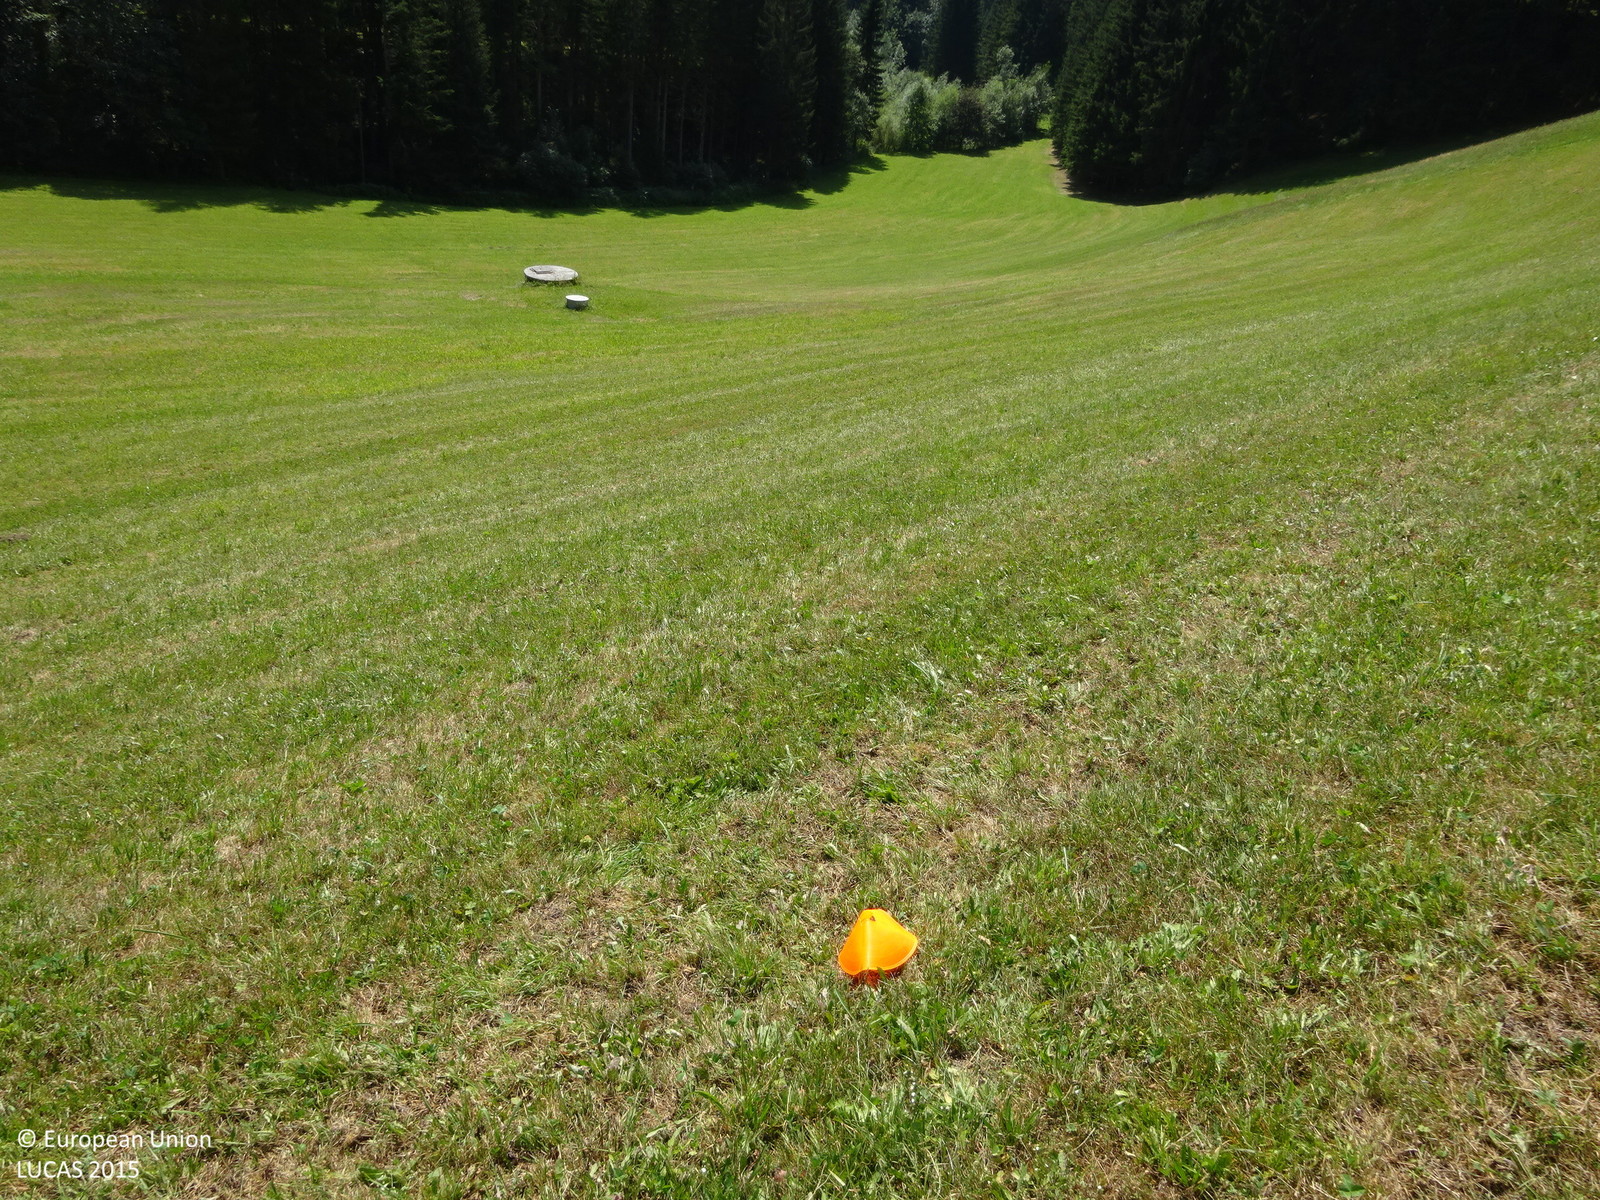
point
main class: Grassland
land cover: Grassland without tree/shrub cover
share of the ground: > 75 %
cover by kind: herbaceous plants 100 %
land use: Agriculture (excluding fallow land and kitchen gardens)
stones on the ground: < 10 %
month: August
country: AT
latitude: 47.4990
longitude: 15.6963
